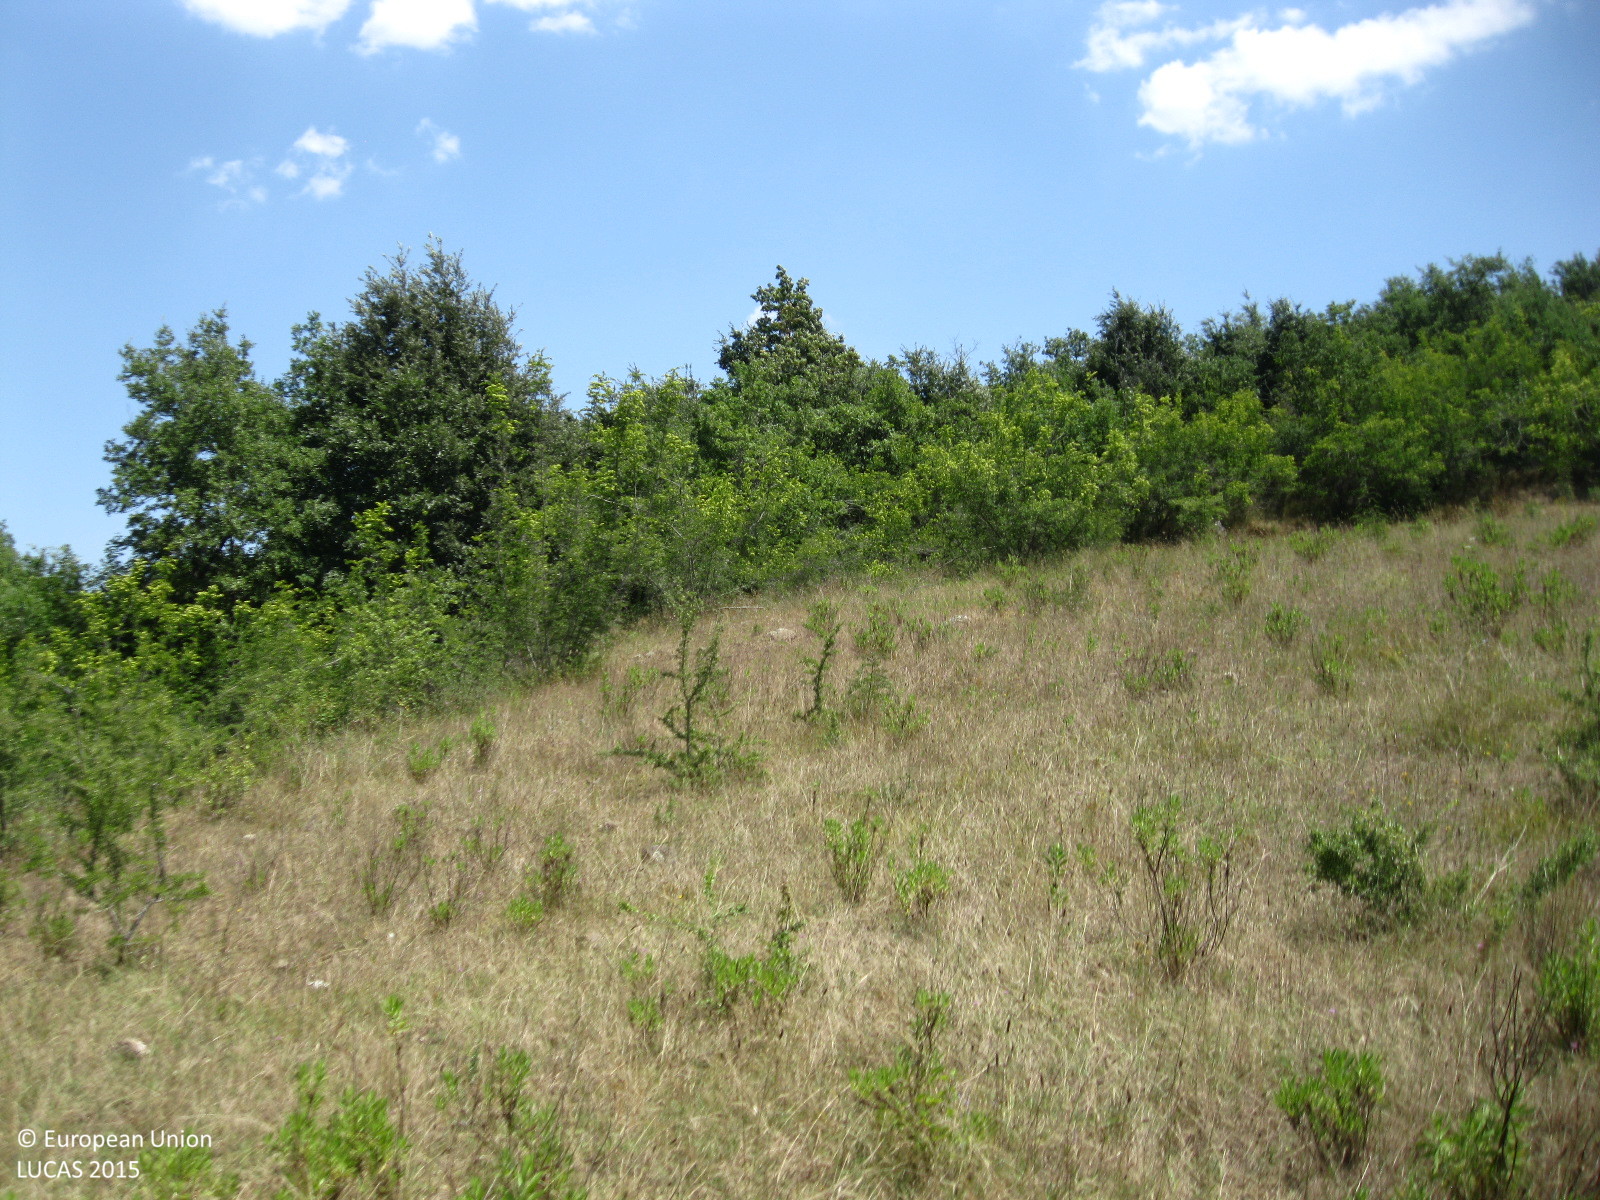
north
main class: Woodland
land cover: Broadleaved woodland
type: thermophilous deciduous forest
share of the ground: > 75 %
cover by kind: broadleaved forest trees 70 %, shrubs 25 %, herbaceous plants 5 %
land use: Forestry
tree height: > 5 m
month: July
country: IT
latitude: 42.6795
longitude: 11.4718
